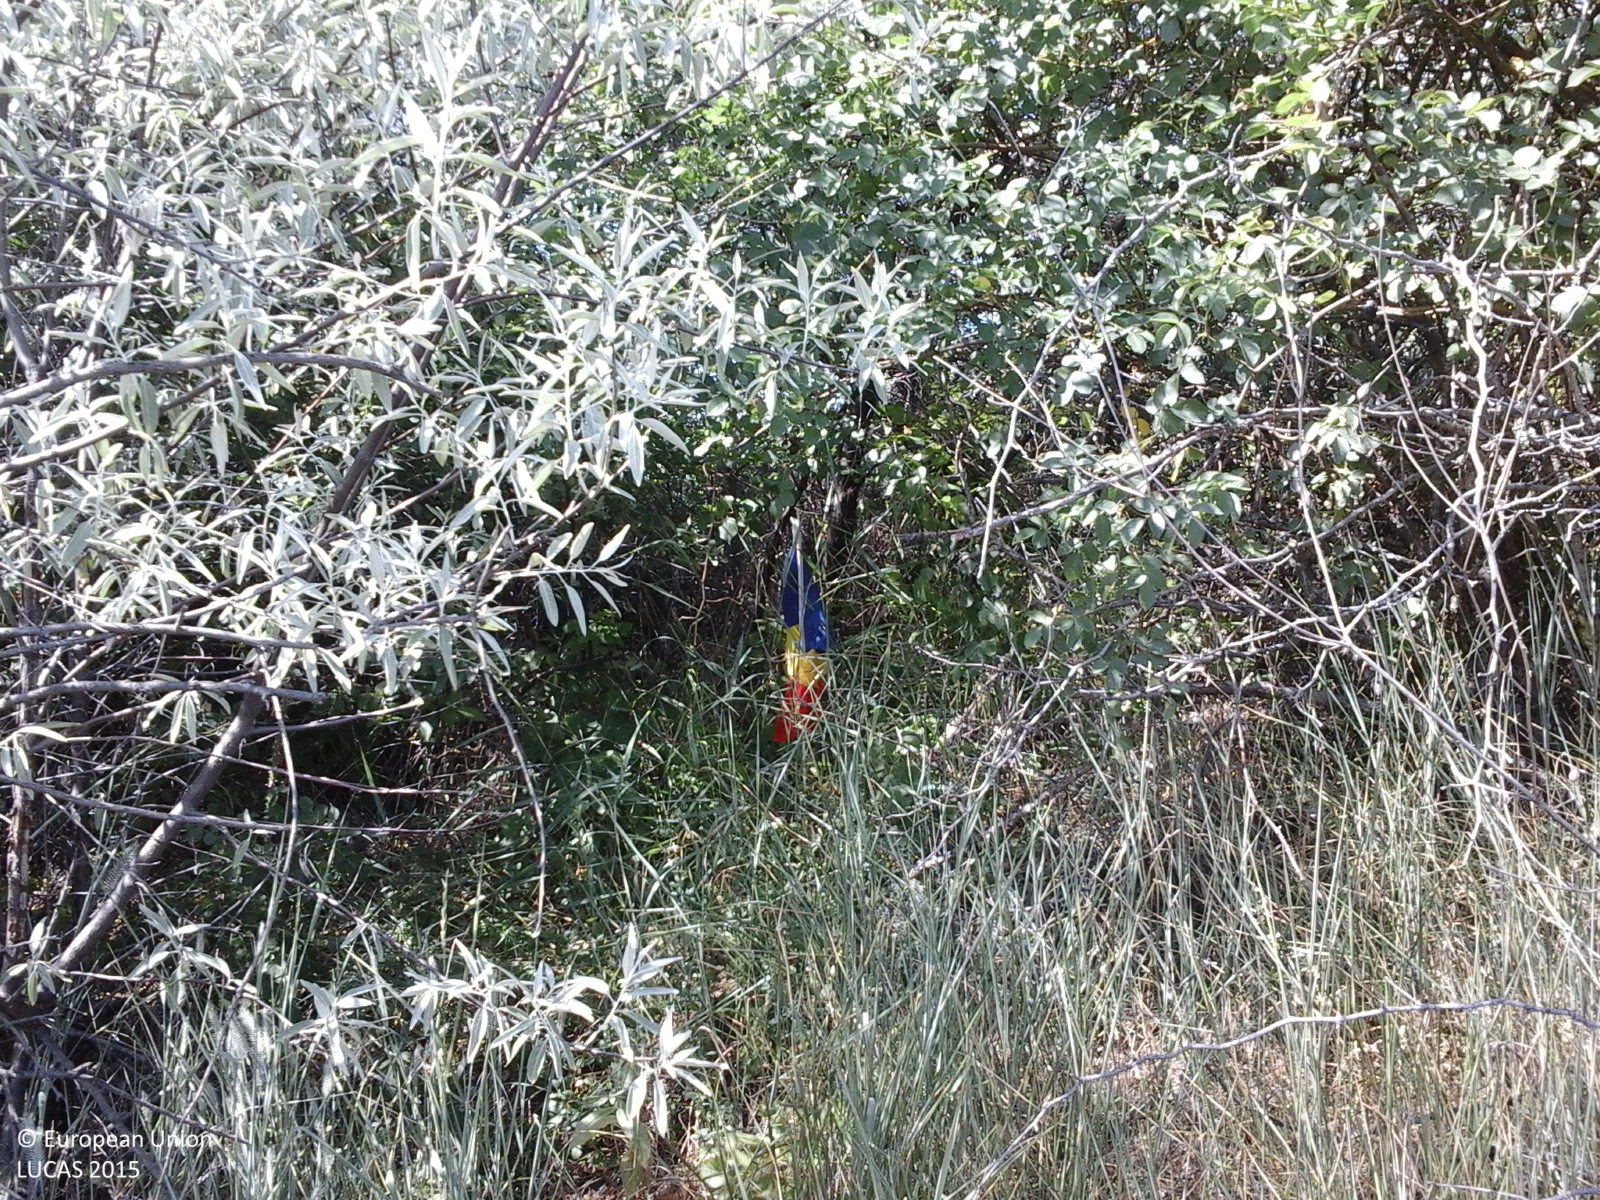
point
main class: Shrubland
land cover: Shrubland with sparse tree cover
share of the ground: > 75 %
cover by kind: shrubs 80 %, herbaceous plants 15 %, broadleaved forest trees 5 %
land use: Agriculture (excluding fallow land and kitchen gardens)
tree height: > 5 m
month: June
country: RO
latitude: 47.5141
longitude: 27.0073
